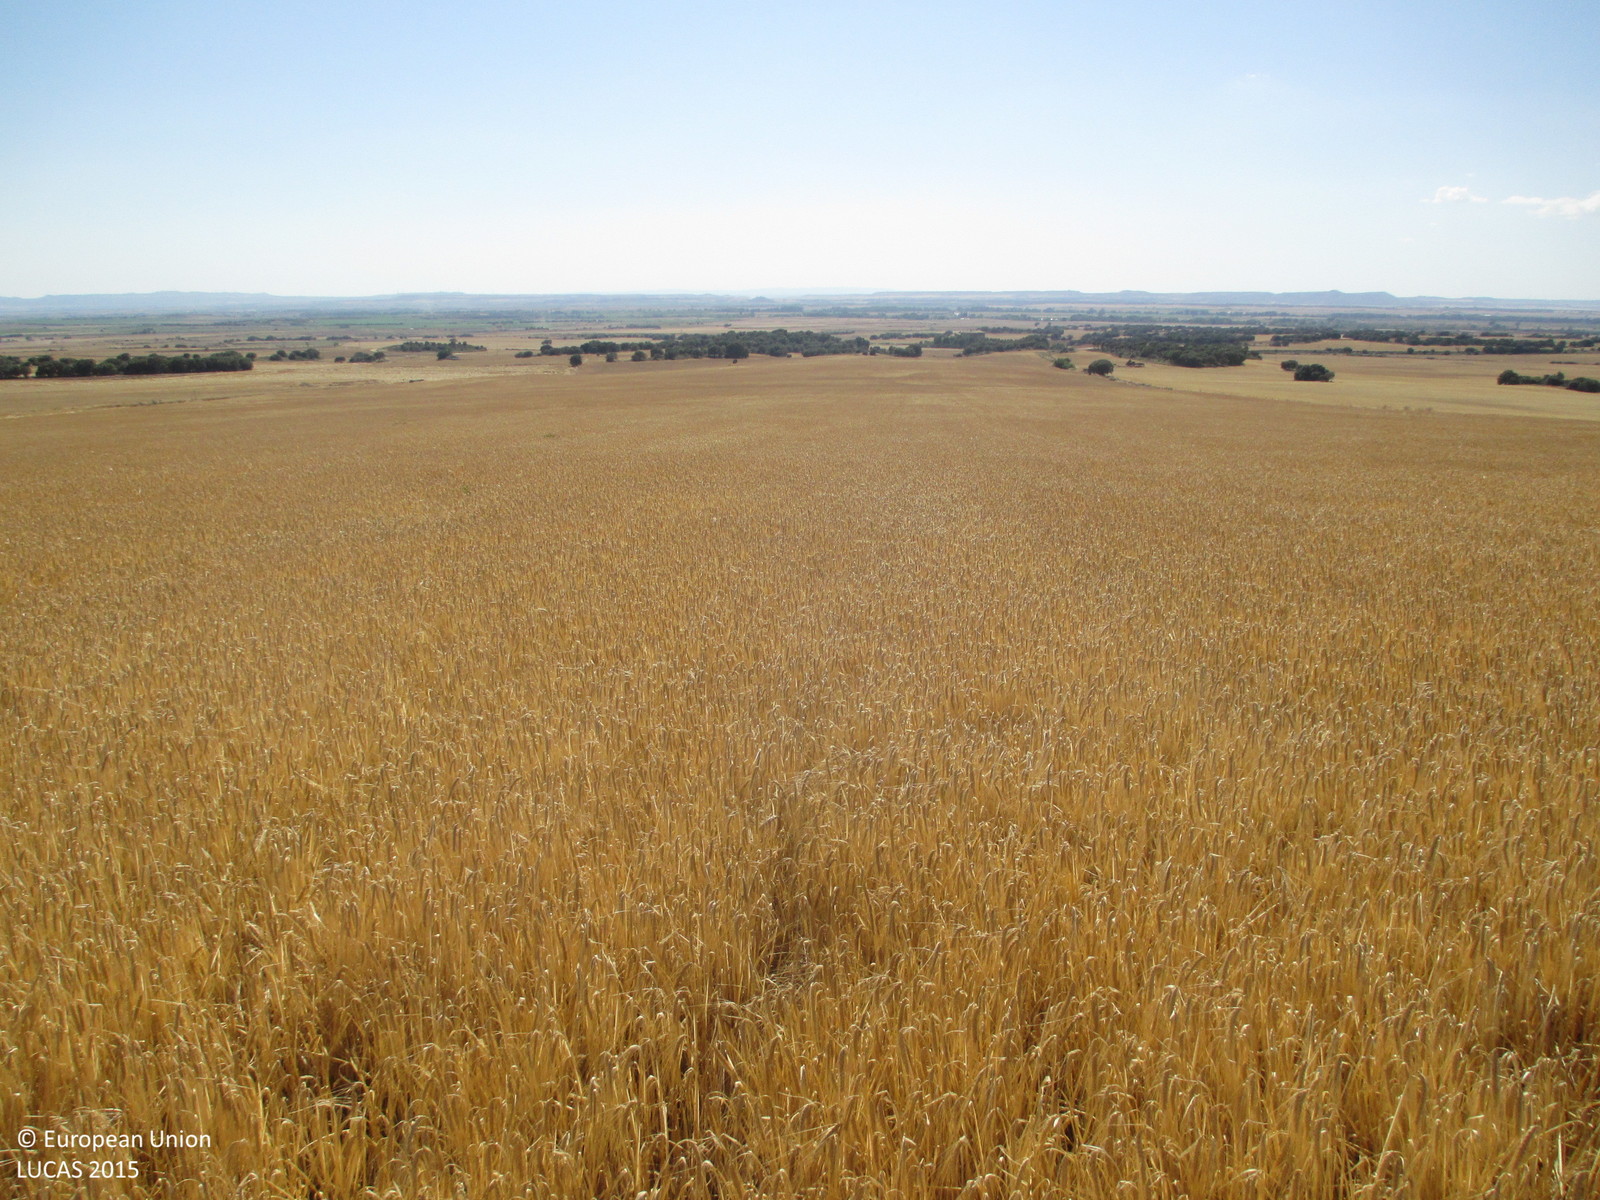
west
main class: Cropland
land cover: Barley
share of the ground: > 75 %
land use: Agriculture (excluding fallow land and kitchen gardens)
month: June
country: ES
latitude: 42.0698
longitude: -0.3308
